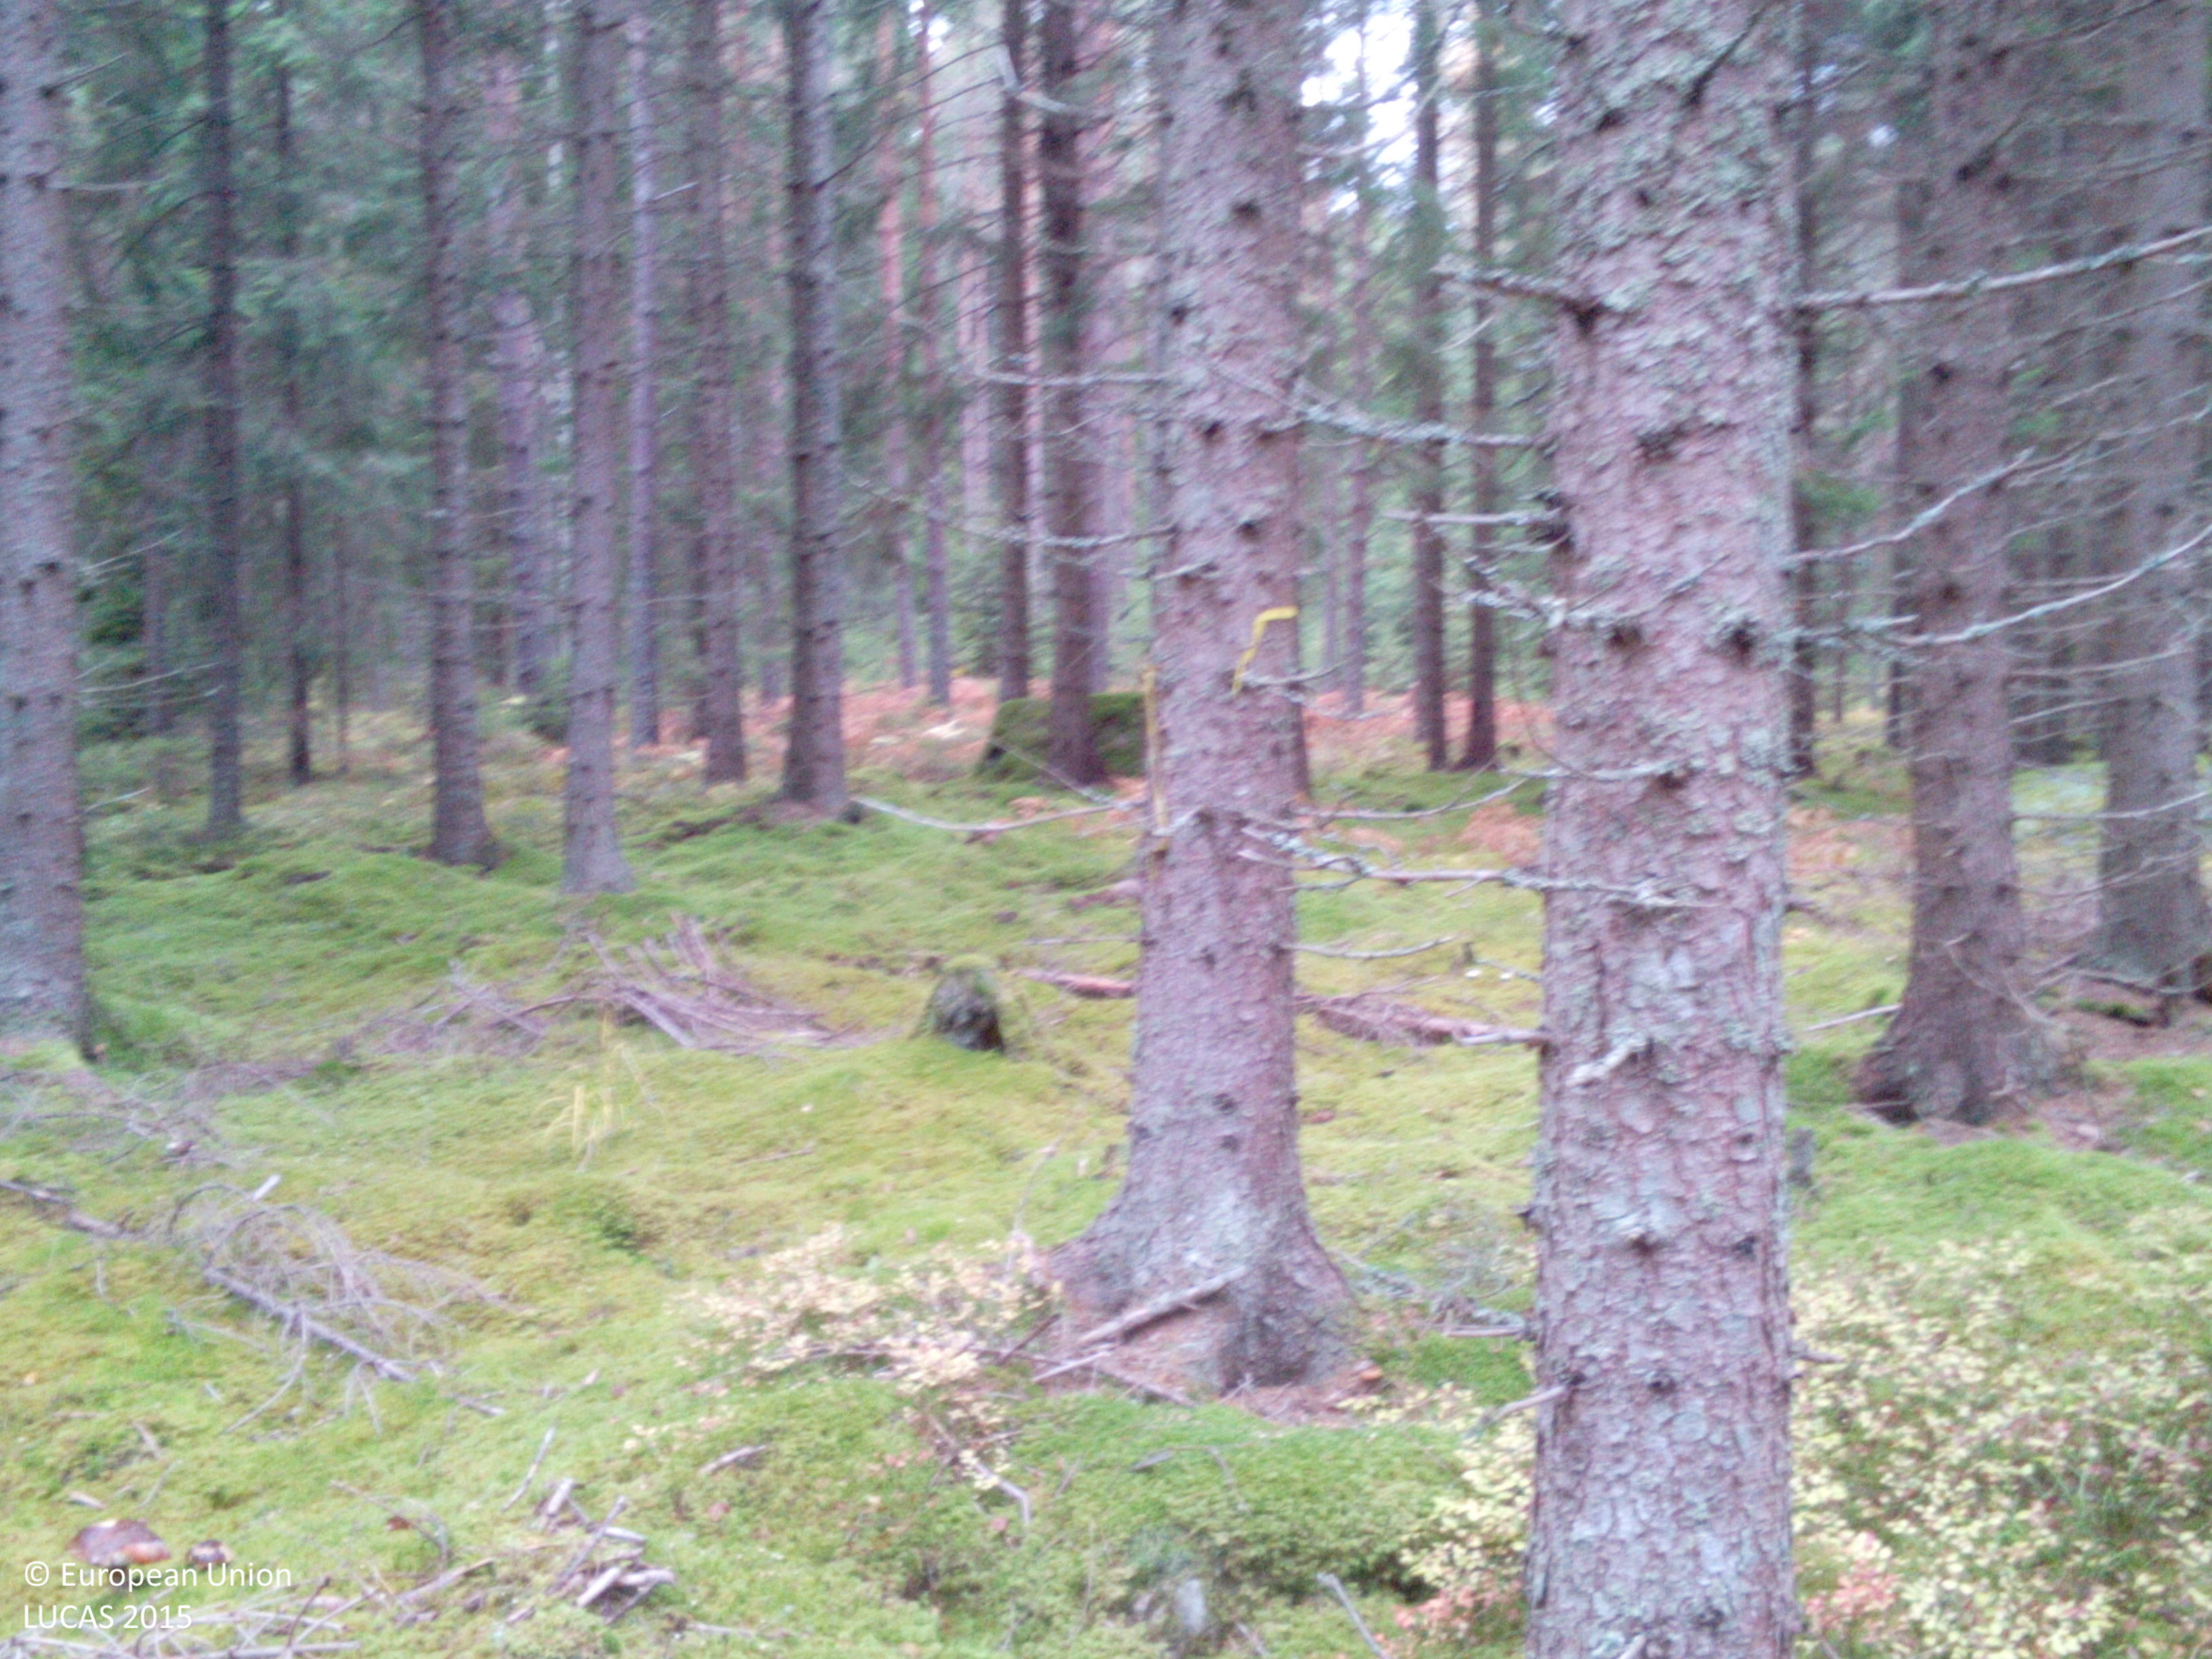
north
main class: Woodland
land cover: Spruce dominated coniferous woodland
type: boreal forest
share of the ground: > 75 %
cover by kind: coniferous forest trees 85 %, lichens and mosses 10 %, herbaceous plants 5 %
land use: Forestry
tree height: > 5 m
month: October
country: SE
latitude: 59.1937
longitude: 16.2427
